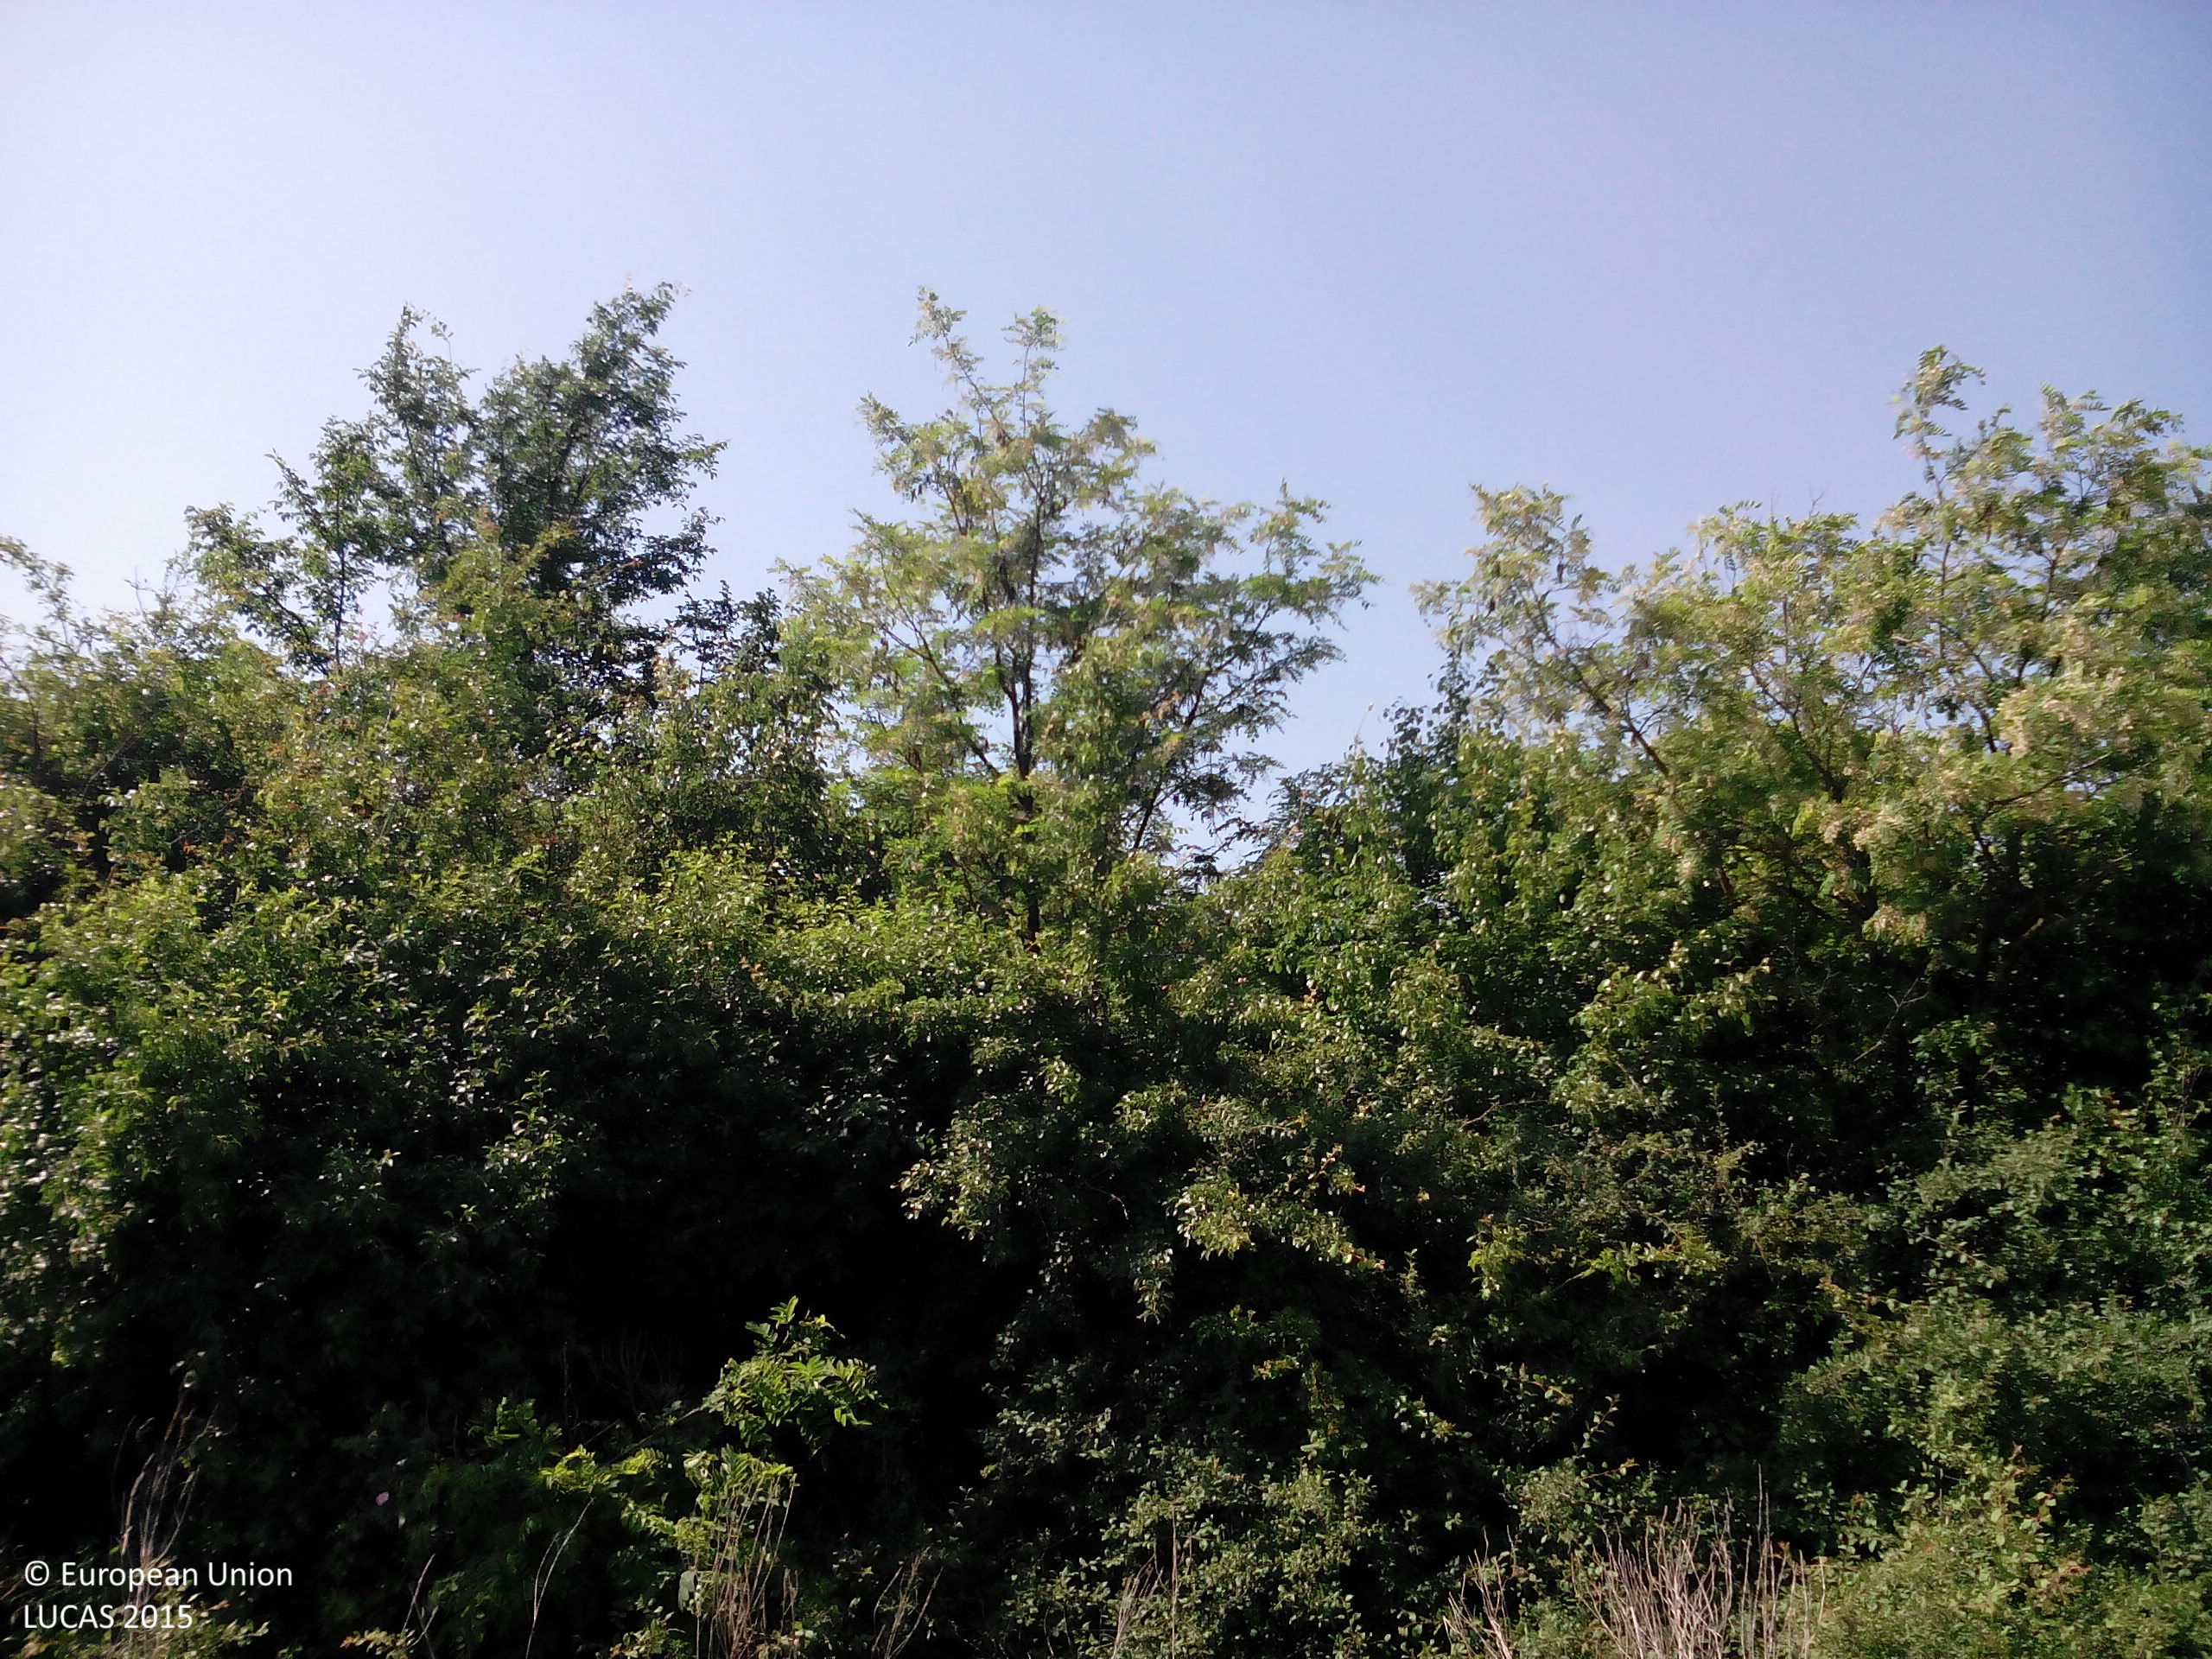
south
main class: Woodland
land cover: Broadleaved woodland
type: thermophilous deciduous forest
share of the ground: > 75 %
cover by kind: broadleaved forest trees 90 %, shrubs 5 %, herbaceous plants 5 %
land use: Forestry
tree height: < 5 m
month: May
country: BG
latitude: 43.5260
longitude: 24.2489
